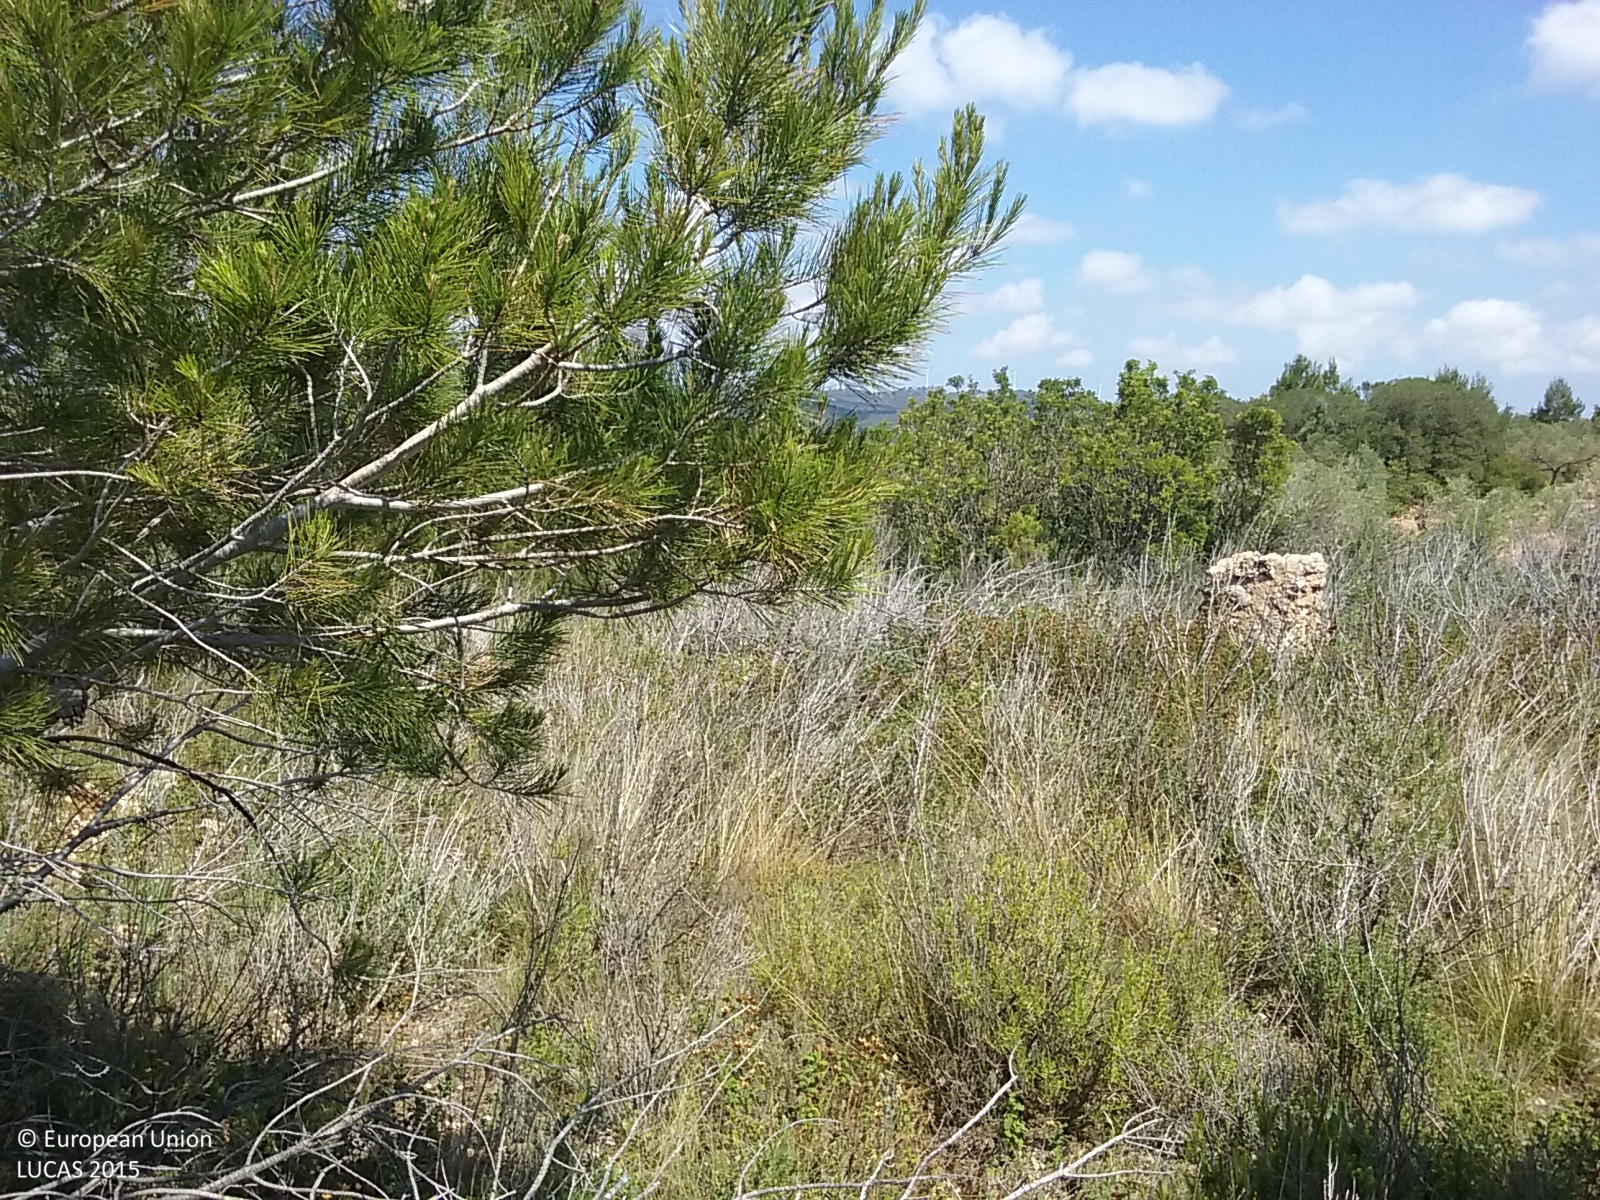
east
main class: Woodland
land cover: Pine dominated coniferous woodland
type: coniferous forest of the mediterranean region
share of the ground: 10 - 25 %
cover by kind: shrubs 75 %, coniferous forest trees 15 %, herbaceous plants 10 %
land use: Semi-natural and natural areas not in use
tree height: < 5 m
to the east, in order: Pine dominated coniferous woodland; Tracks; Pine dominated coniferous woodland; Dry stone walls; Olive groves; Dry stone walls; Olive groves; Dry stone walls; Pine dominated coniferous woodland; Dry stone walls; Olive groves; Dry stone walls; Olive groves; Dry stone walls; Olive groves; Dry stone walls; Olive groves; Dry stone walls; Olive groves; Dry stone walls; Olive groves
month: June
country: ES
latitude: 40.9297
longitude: 0.6470
